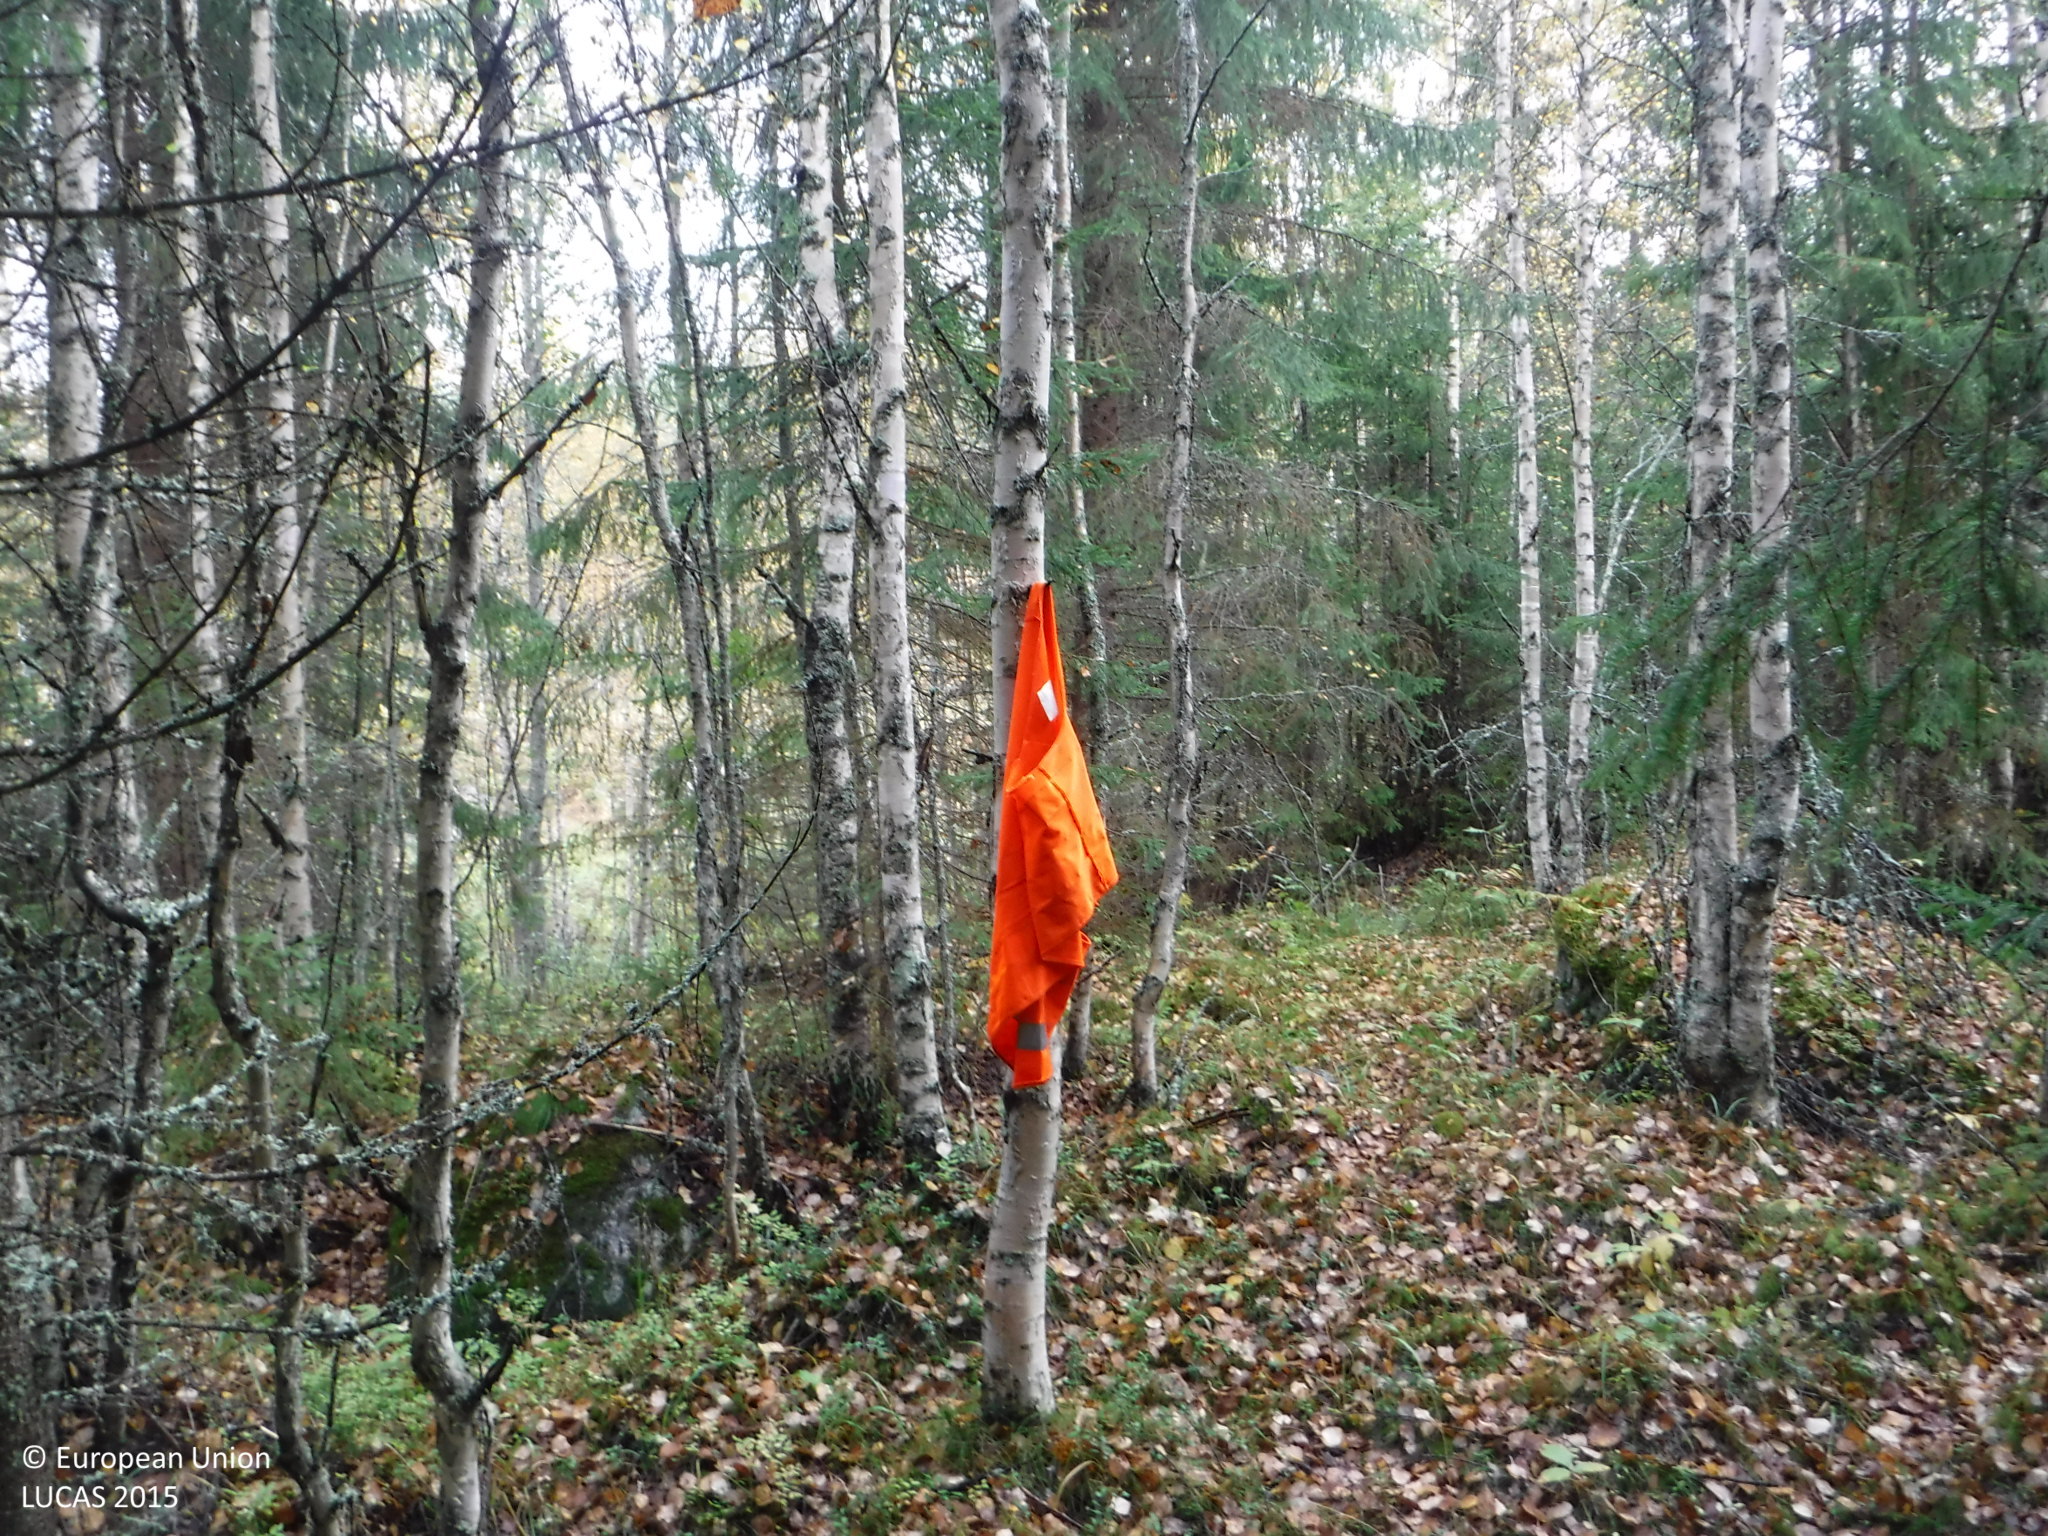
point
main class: Woodland
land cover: Spruce dominated mixed woodland
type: boreal forest
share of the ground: 50 - 75 %
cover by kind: coniferous forest trees 40 %, broadleaved forest trees 30 %, lichens and mosses 20 %, shrubs 10 %
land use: Forestry
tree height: > 5 m
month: September
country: FI
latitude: 61.8388
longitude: 24.2406
